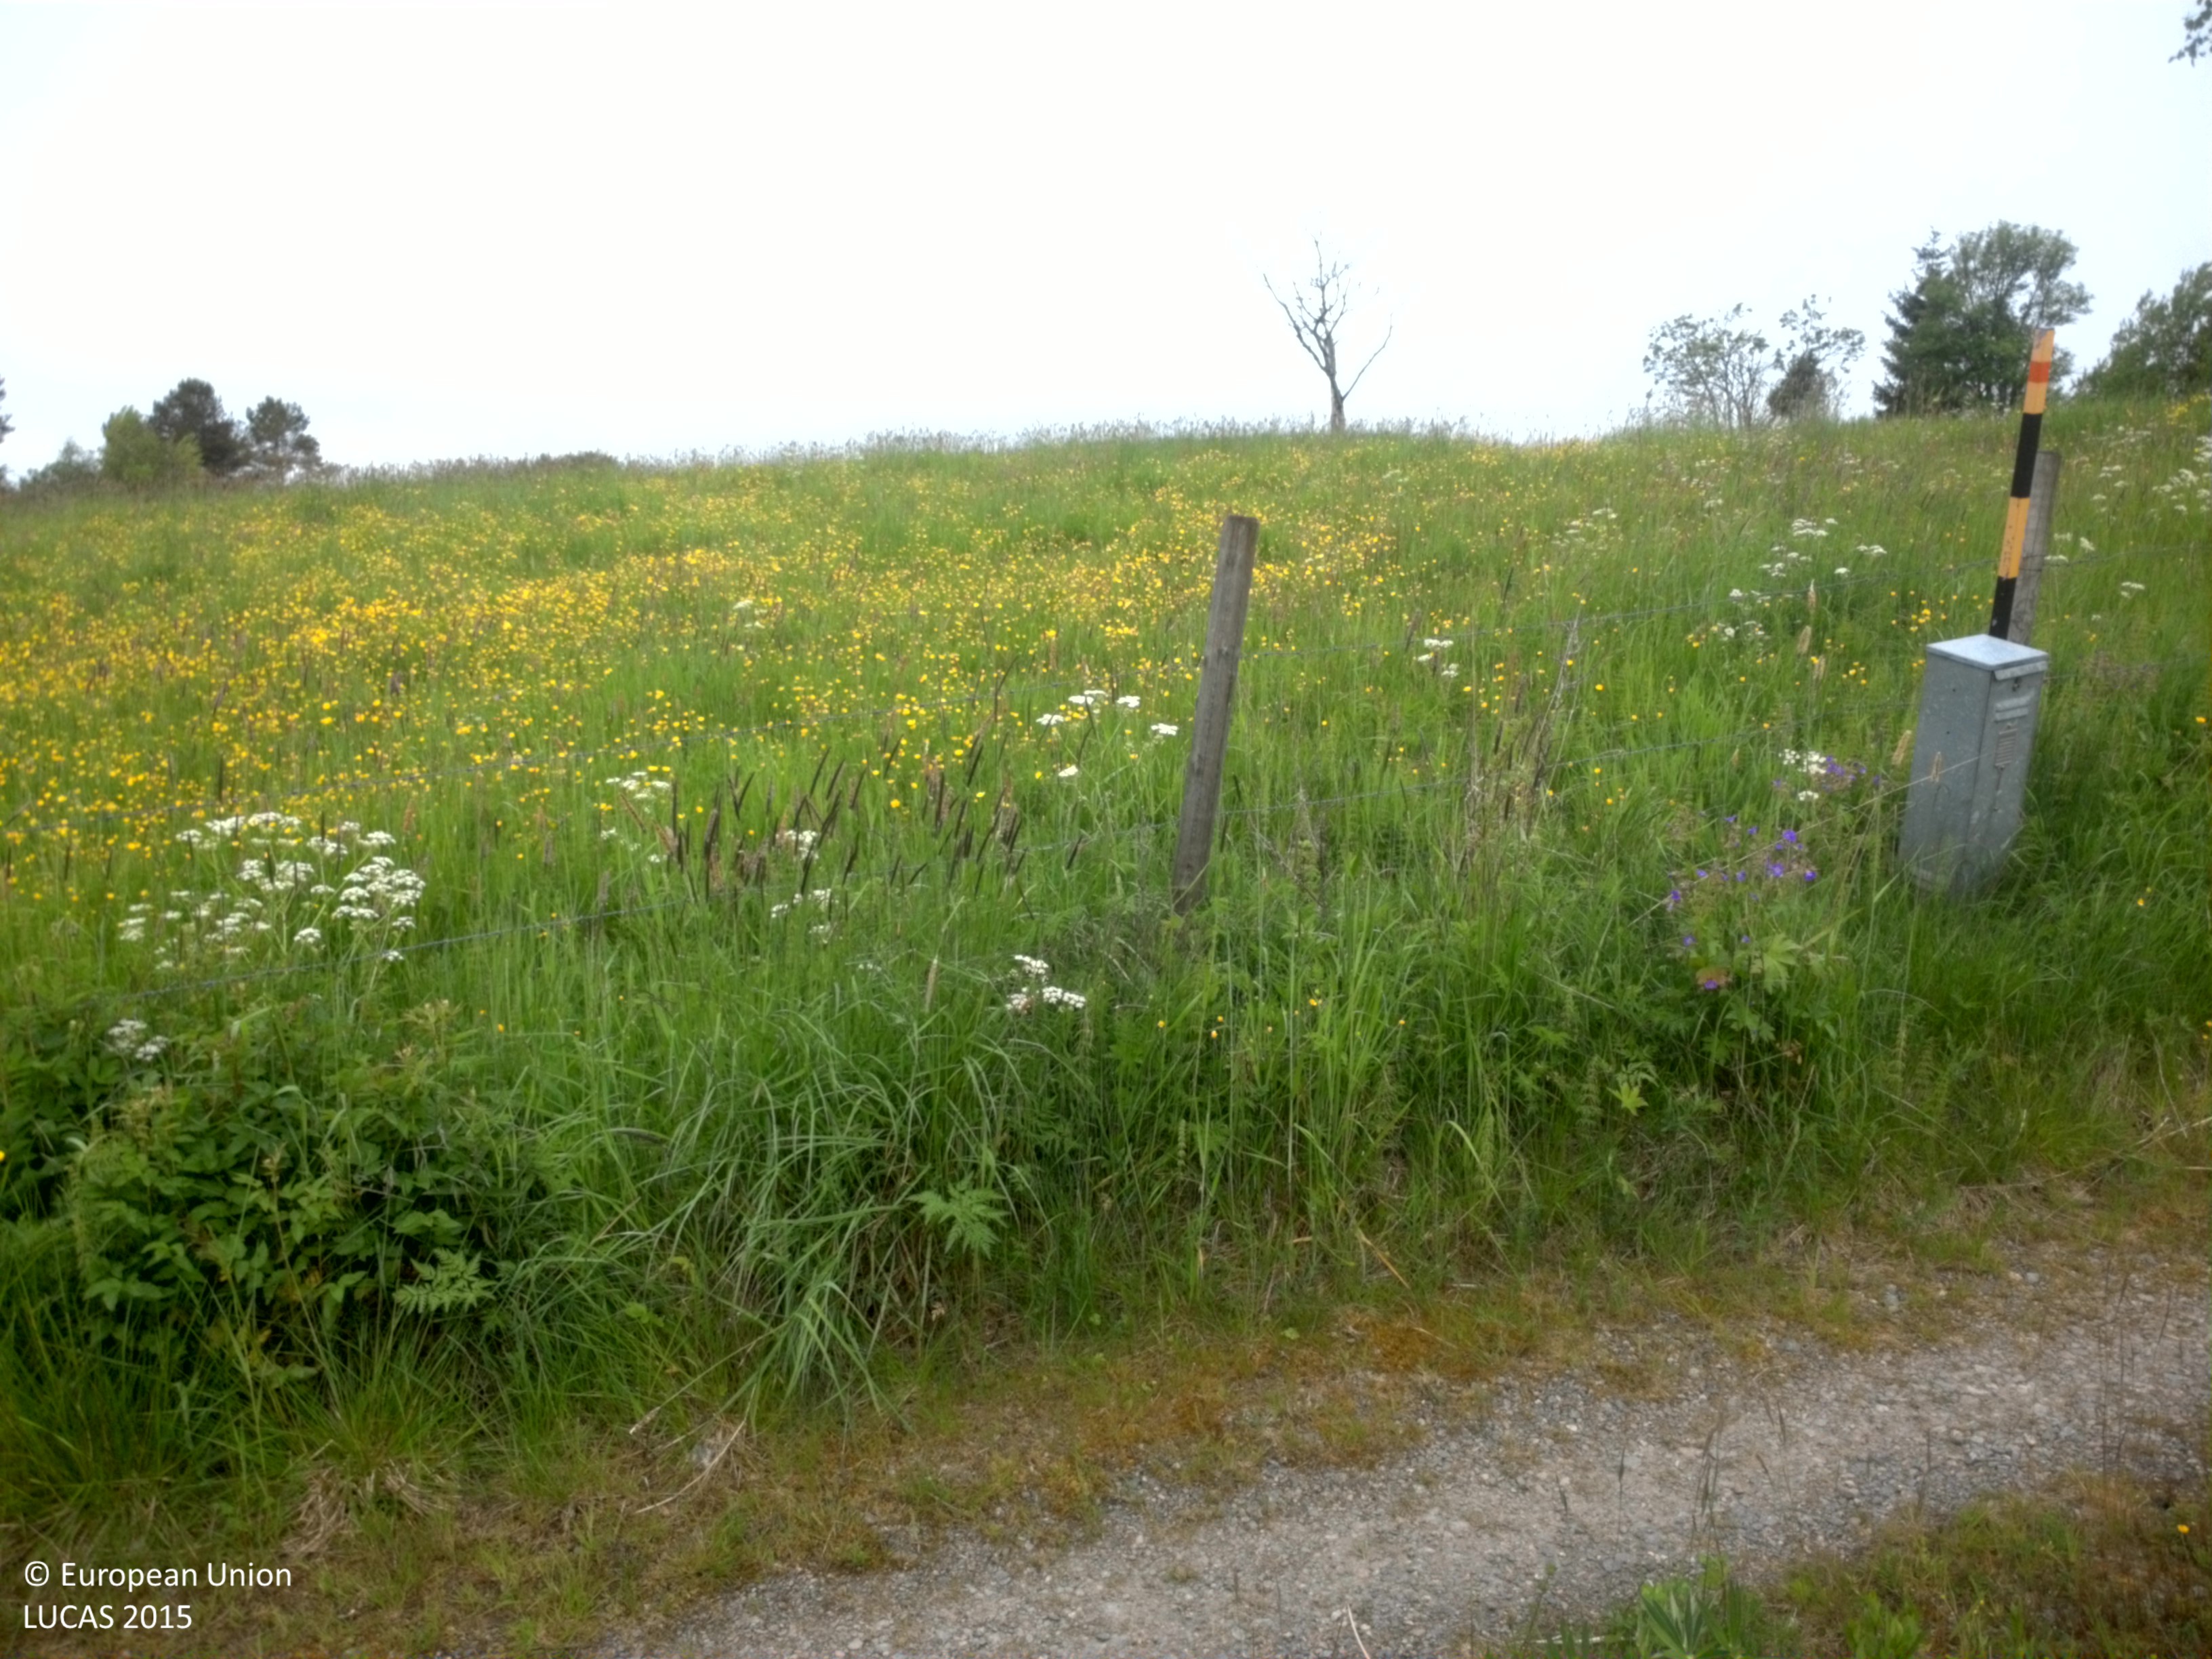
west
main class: Grassland
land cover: Grassland with sparse tree/shrub cover
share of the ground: > 75 %
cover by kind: herbaceous plants 90 %, broadleaved forest trees 5 %, shrubs 5 %
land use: Agriculture (excluding fallow land and kitchen gardens)
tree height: > 5 m
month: June
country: SE
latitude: 59.5883
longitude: 12.1373
